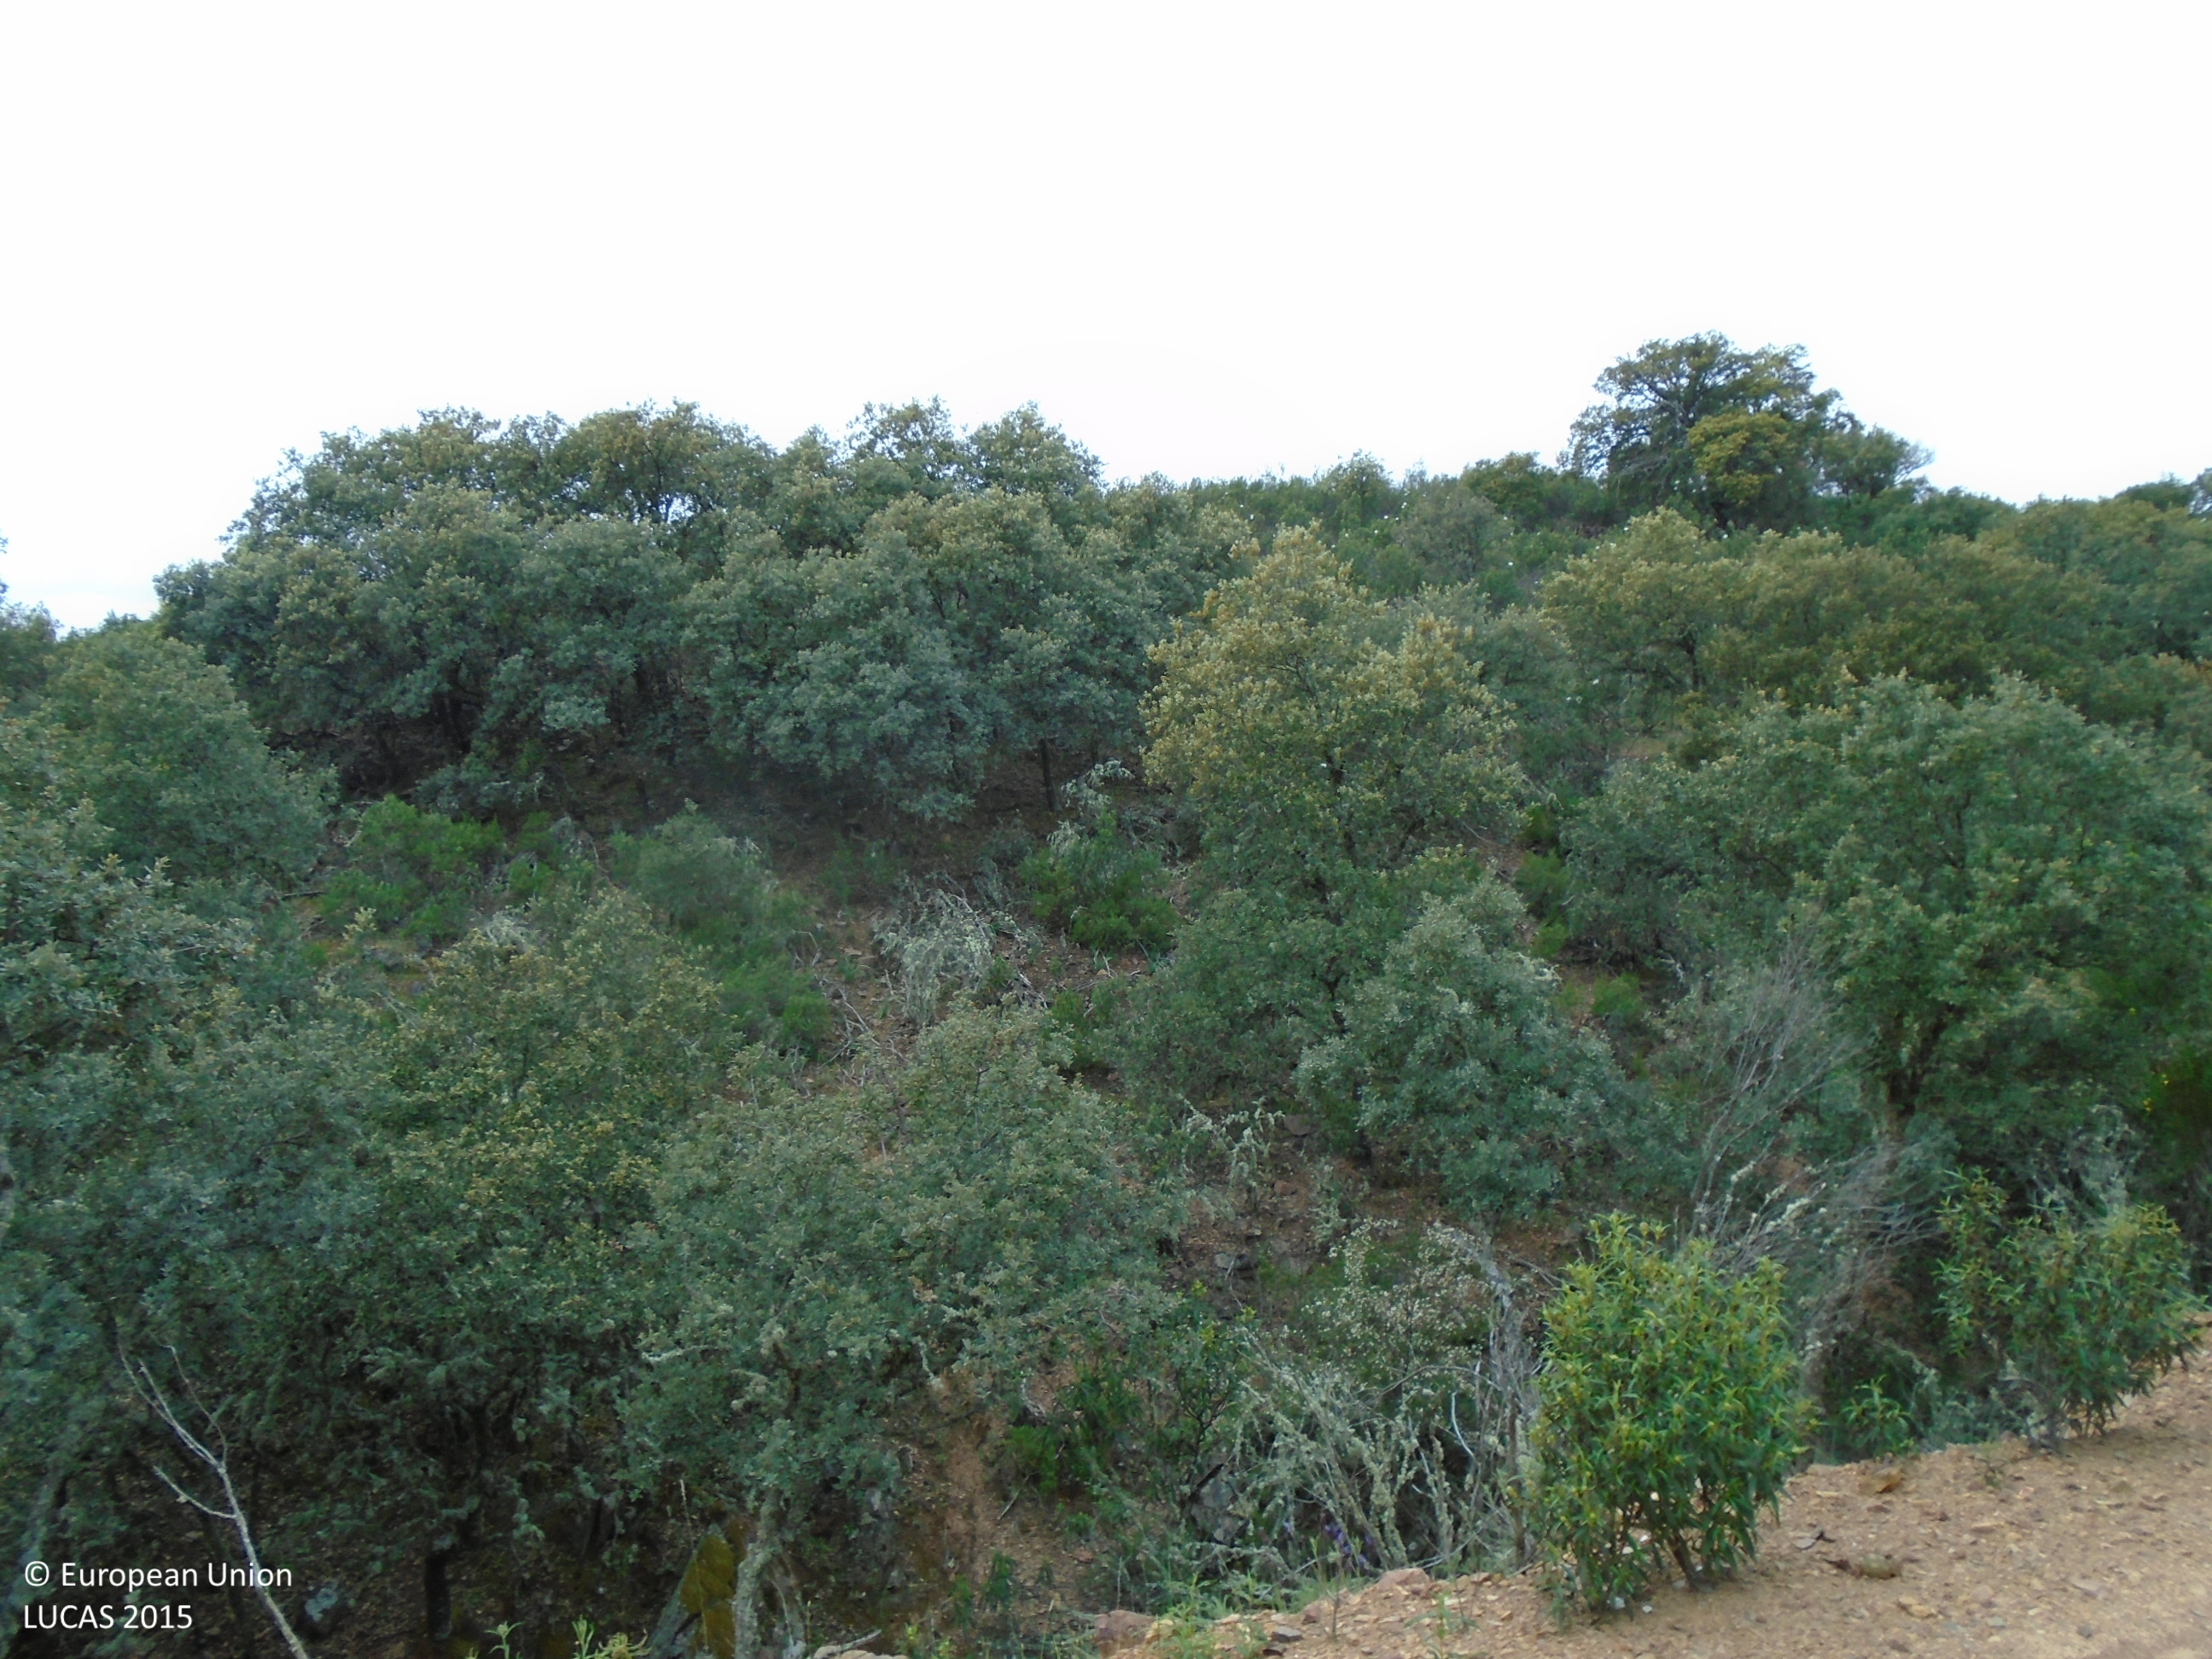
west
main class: Shrubland
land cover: Shrubland without tree cover
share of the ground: > 75 %
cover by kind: shrubs 95 %, consolidated bare surface 5 %
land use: Semi-natural and natural areas not in use
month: May
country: ES
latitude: 39.6508
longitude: -4.9270
